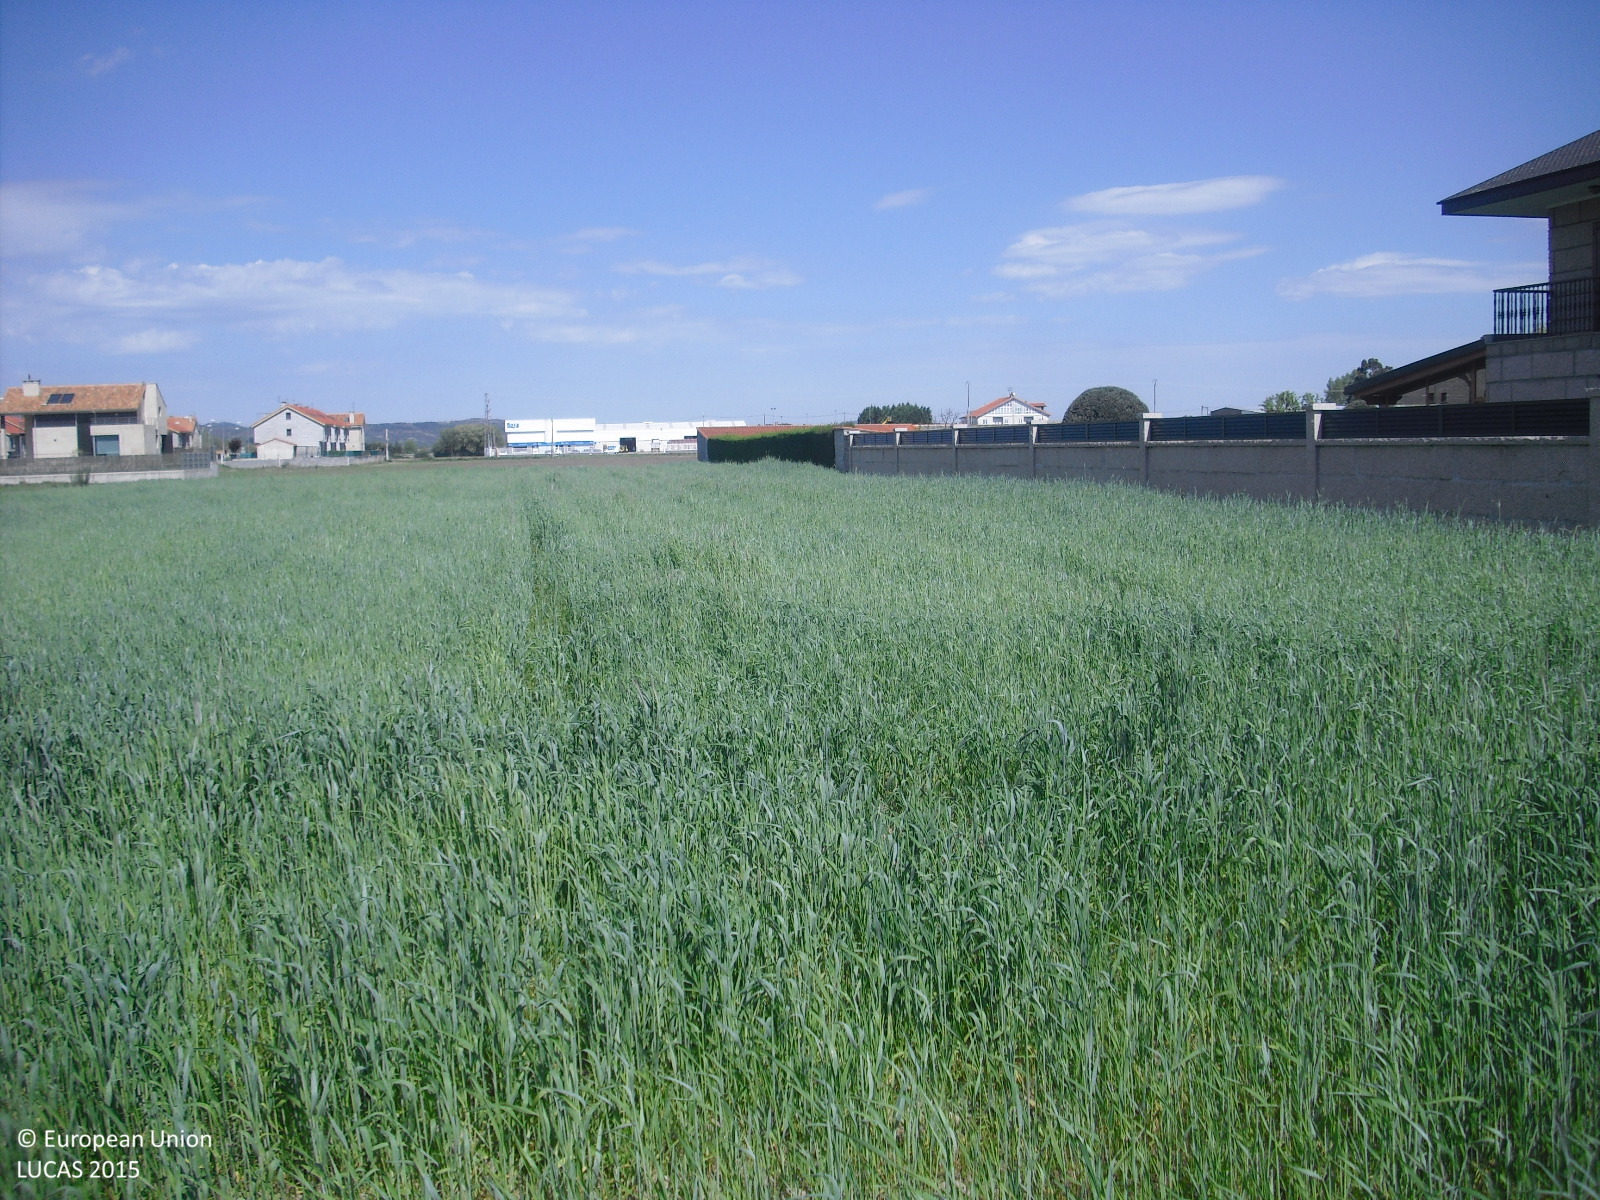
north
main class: Cropland
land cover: Rye
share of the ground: > 75 %
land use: Agriculture (excluding fallow land and kitchen gardens)
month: April
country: ES
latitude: 42.0715
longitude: -7.7277
